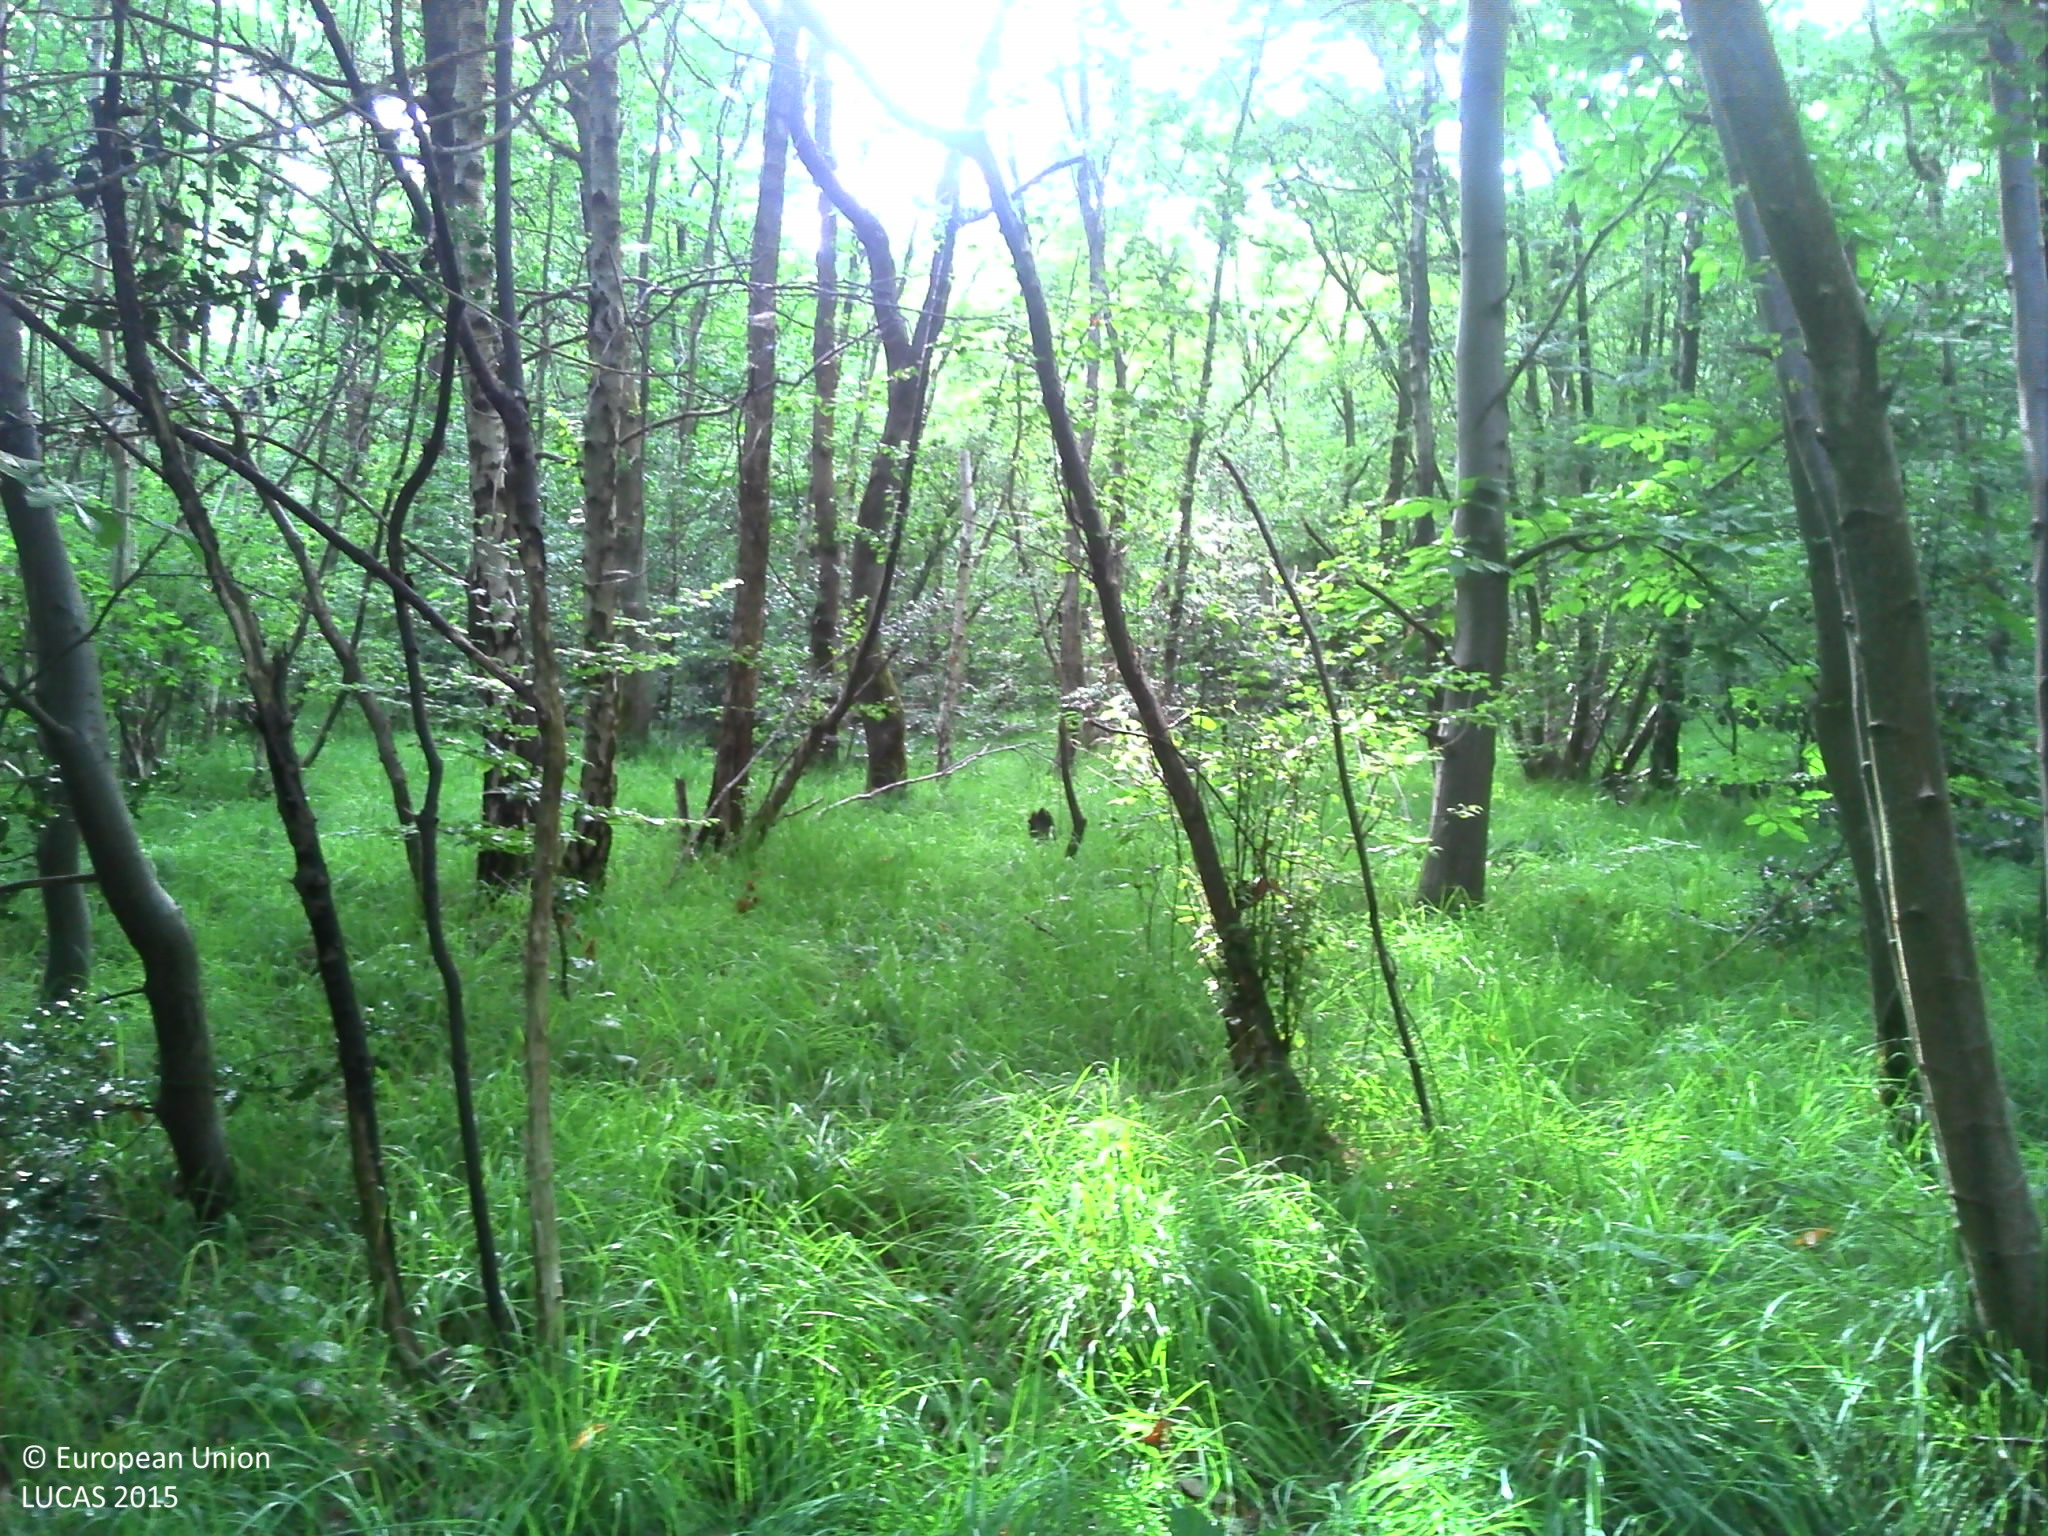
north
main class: Woodland
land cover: Broadleaved woodland
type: mesophytic deciduous forest
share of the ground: 25 - 50 %
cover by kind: herbaceous plants 60 %, broadleaved forest trees 40 %
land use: Forestry
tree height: > 5 m
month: July
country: FR
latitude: 49.4130
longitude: 0.3651
